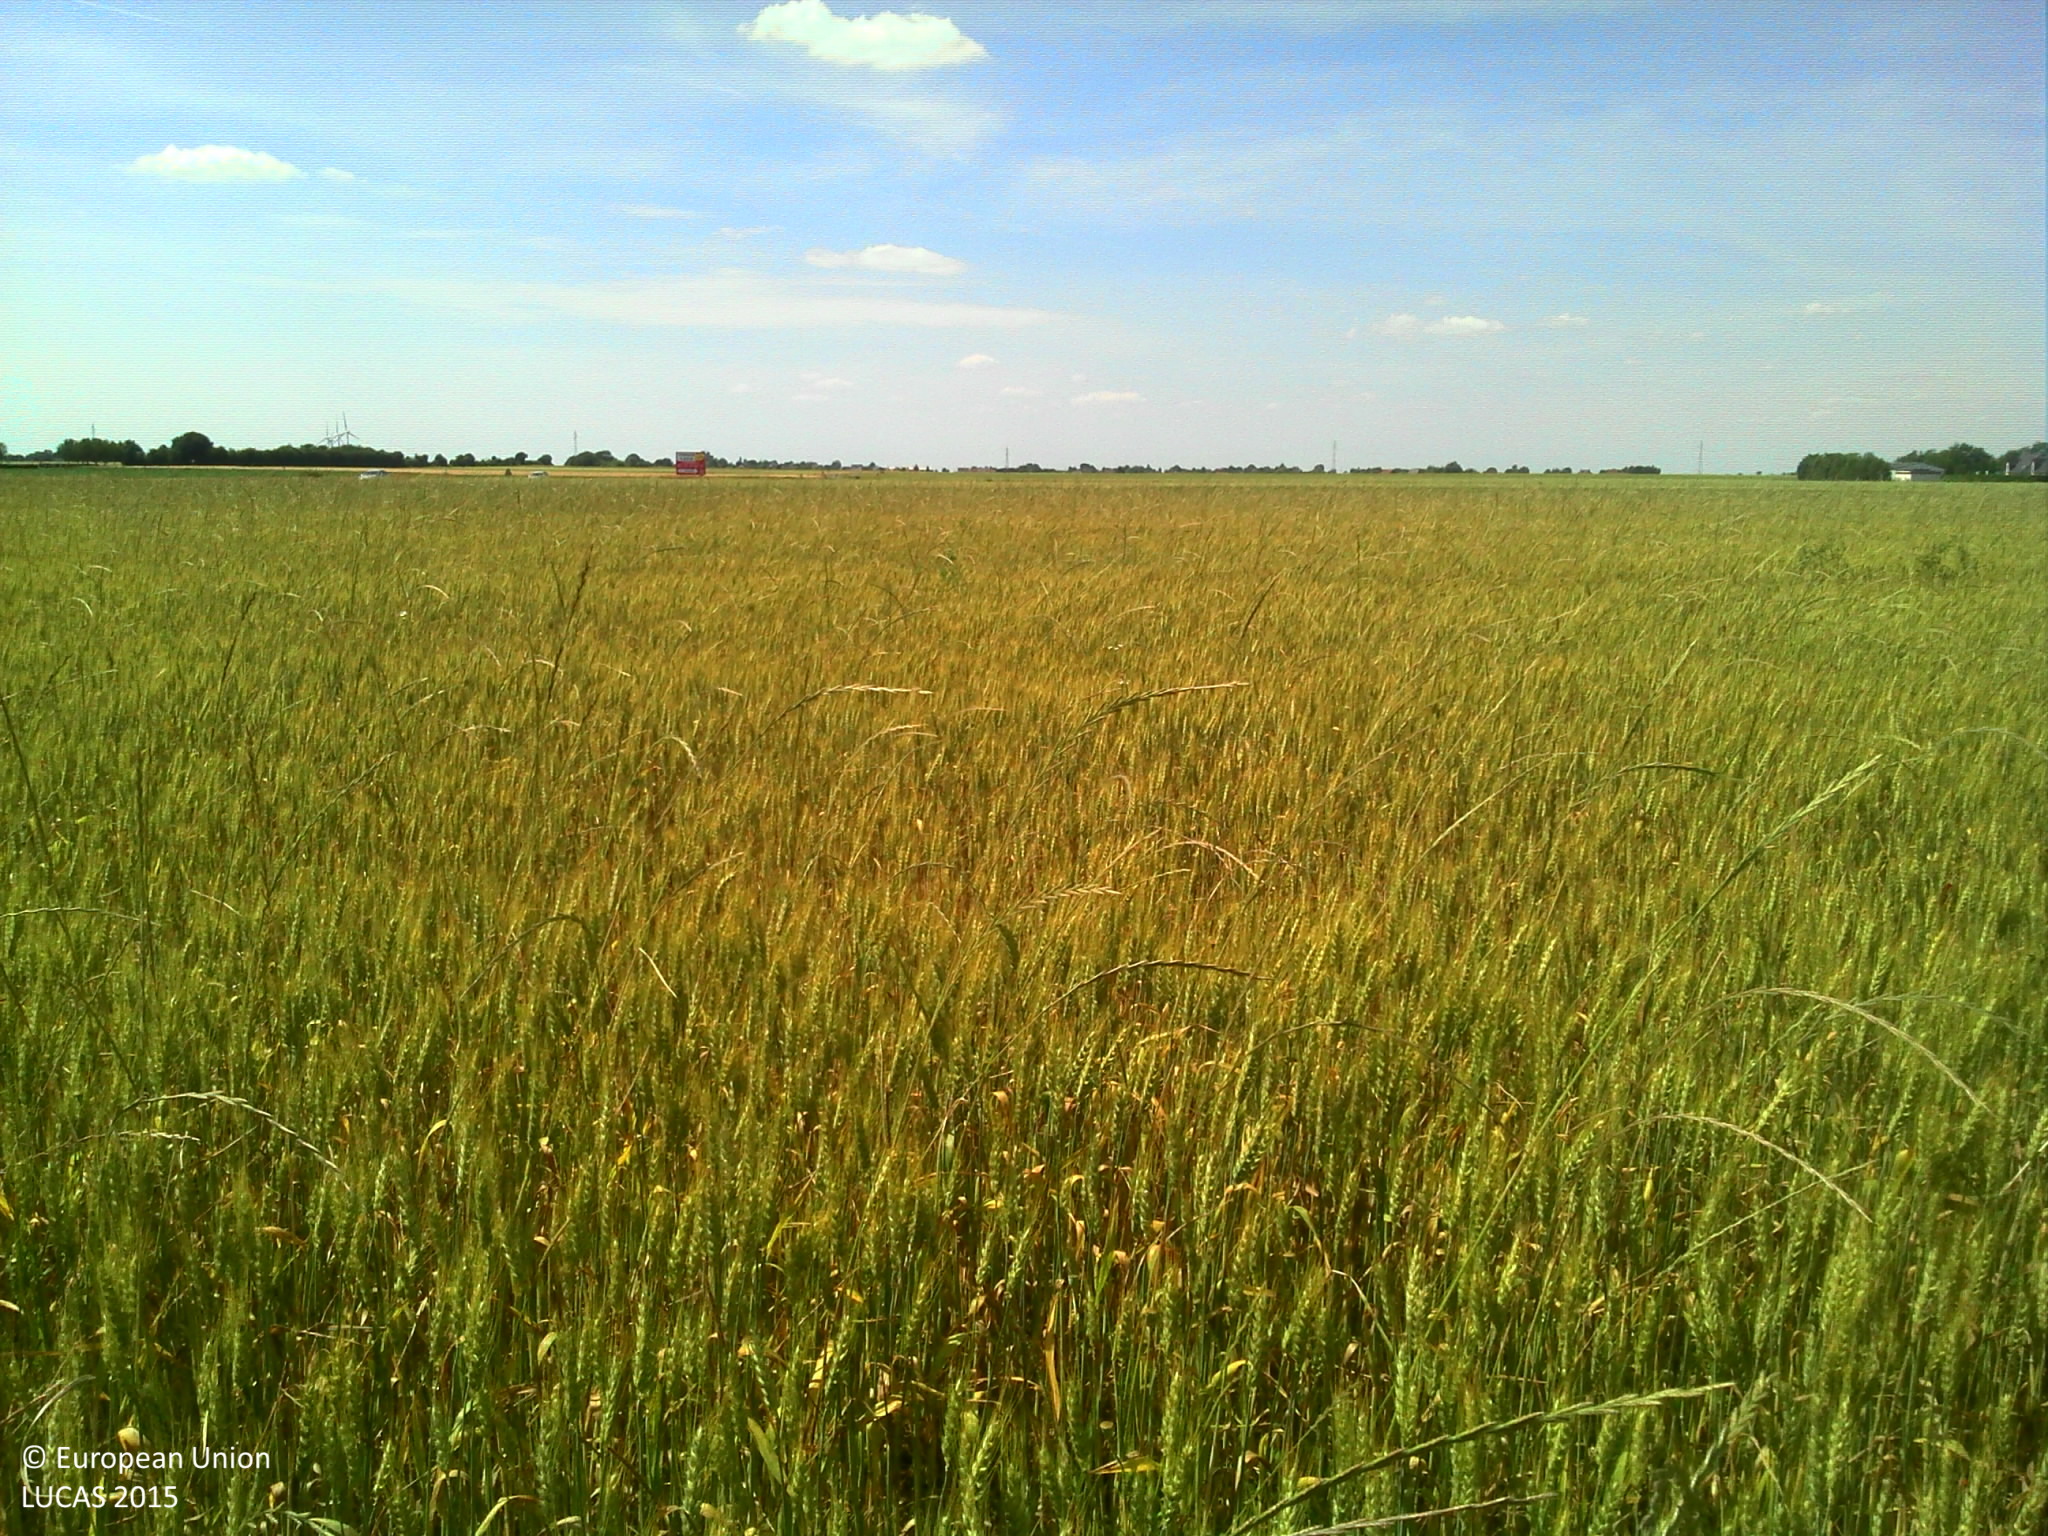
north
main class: Cropland
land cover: Common wheat
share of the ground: > 75 %
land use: Agriculture (excluding fallow land and kitchen gardens)
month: June
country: FR
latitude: 49.0730
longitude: 1.0673
